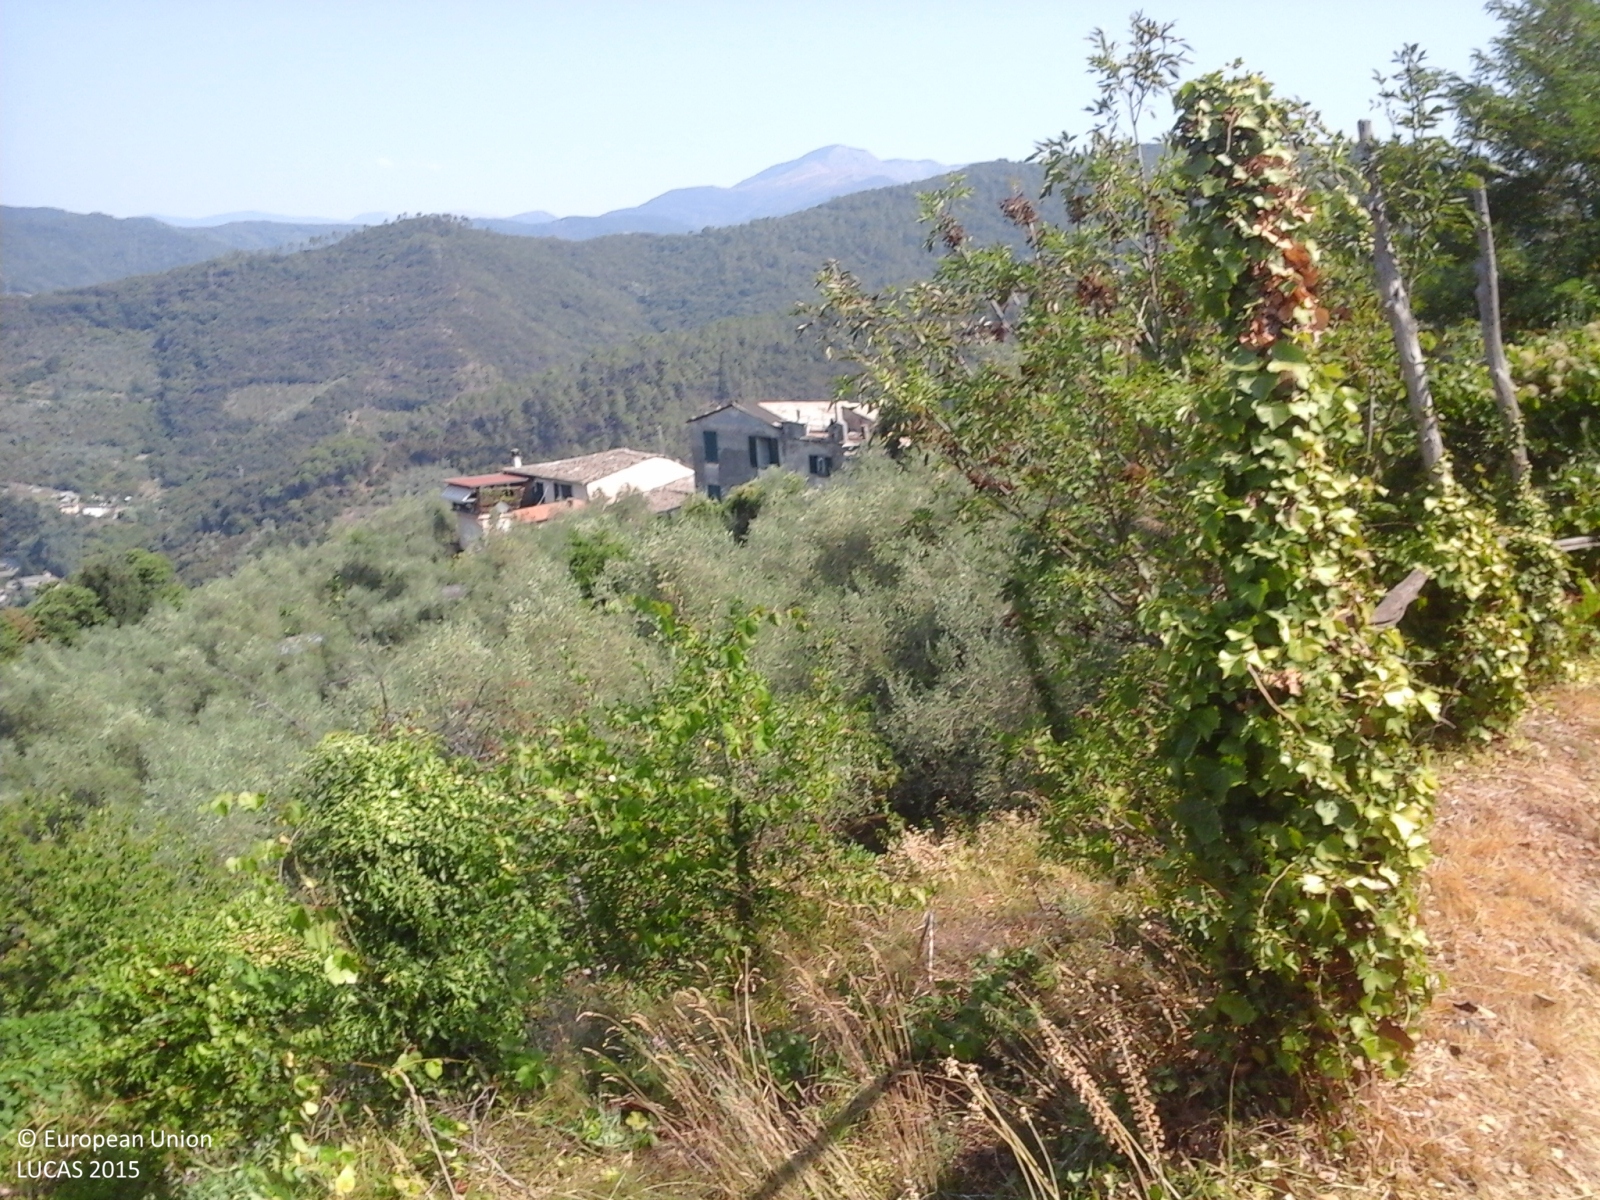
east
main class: Cropland
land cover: Olive groves
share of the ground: > 75 %
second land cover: Grassland without tree/shrub cover
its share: > 75 %
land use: Agriculture (excluding fallow land and kitchen gardens)
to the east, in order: Olive groves; Grassland without tree/shrub cover; Tracks; Olive groves; Grass margins; Broadleaved woodland; Paved roads, cycling and walking lanes; Electric lines; Broadleaved woodland
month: August
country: IT
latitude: 44.3308
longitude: 9.4120
